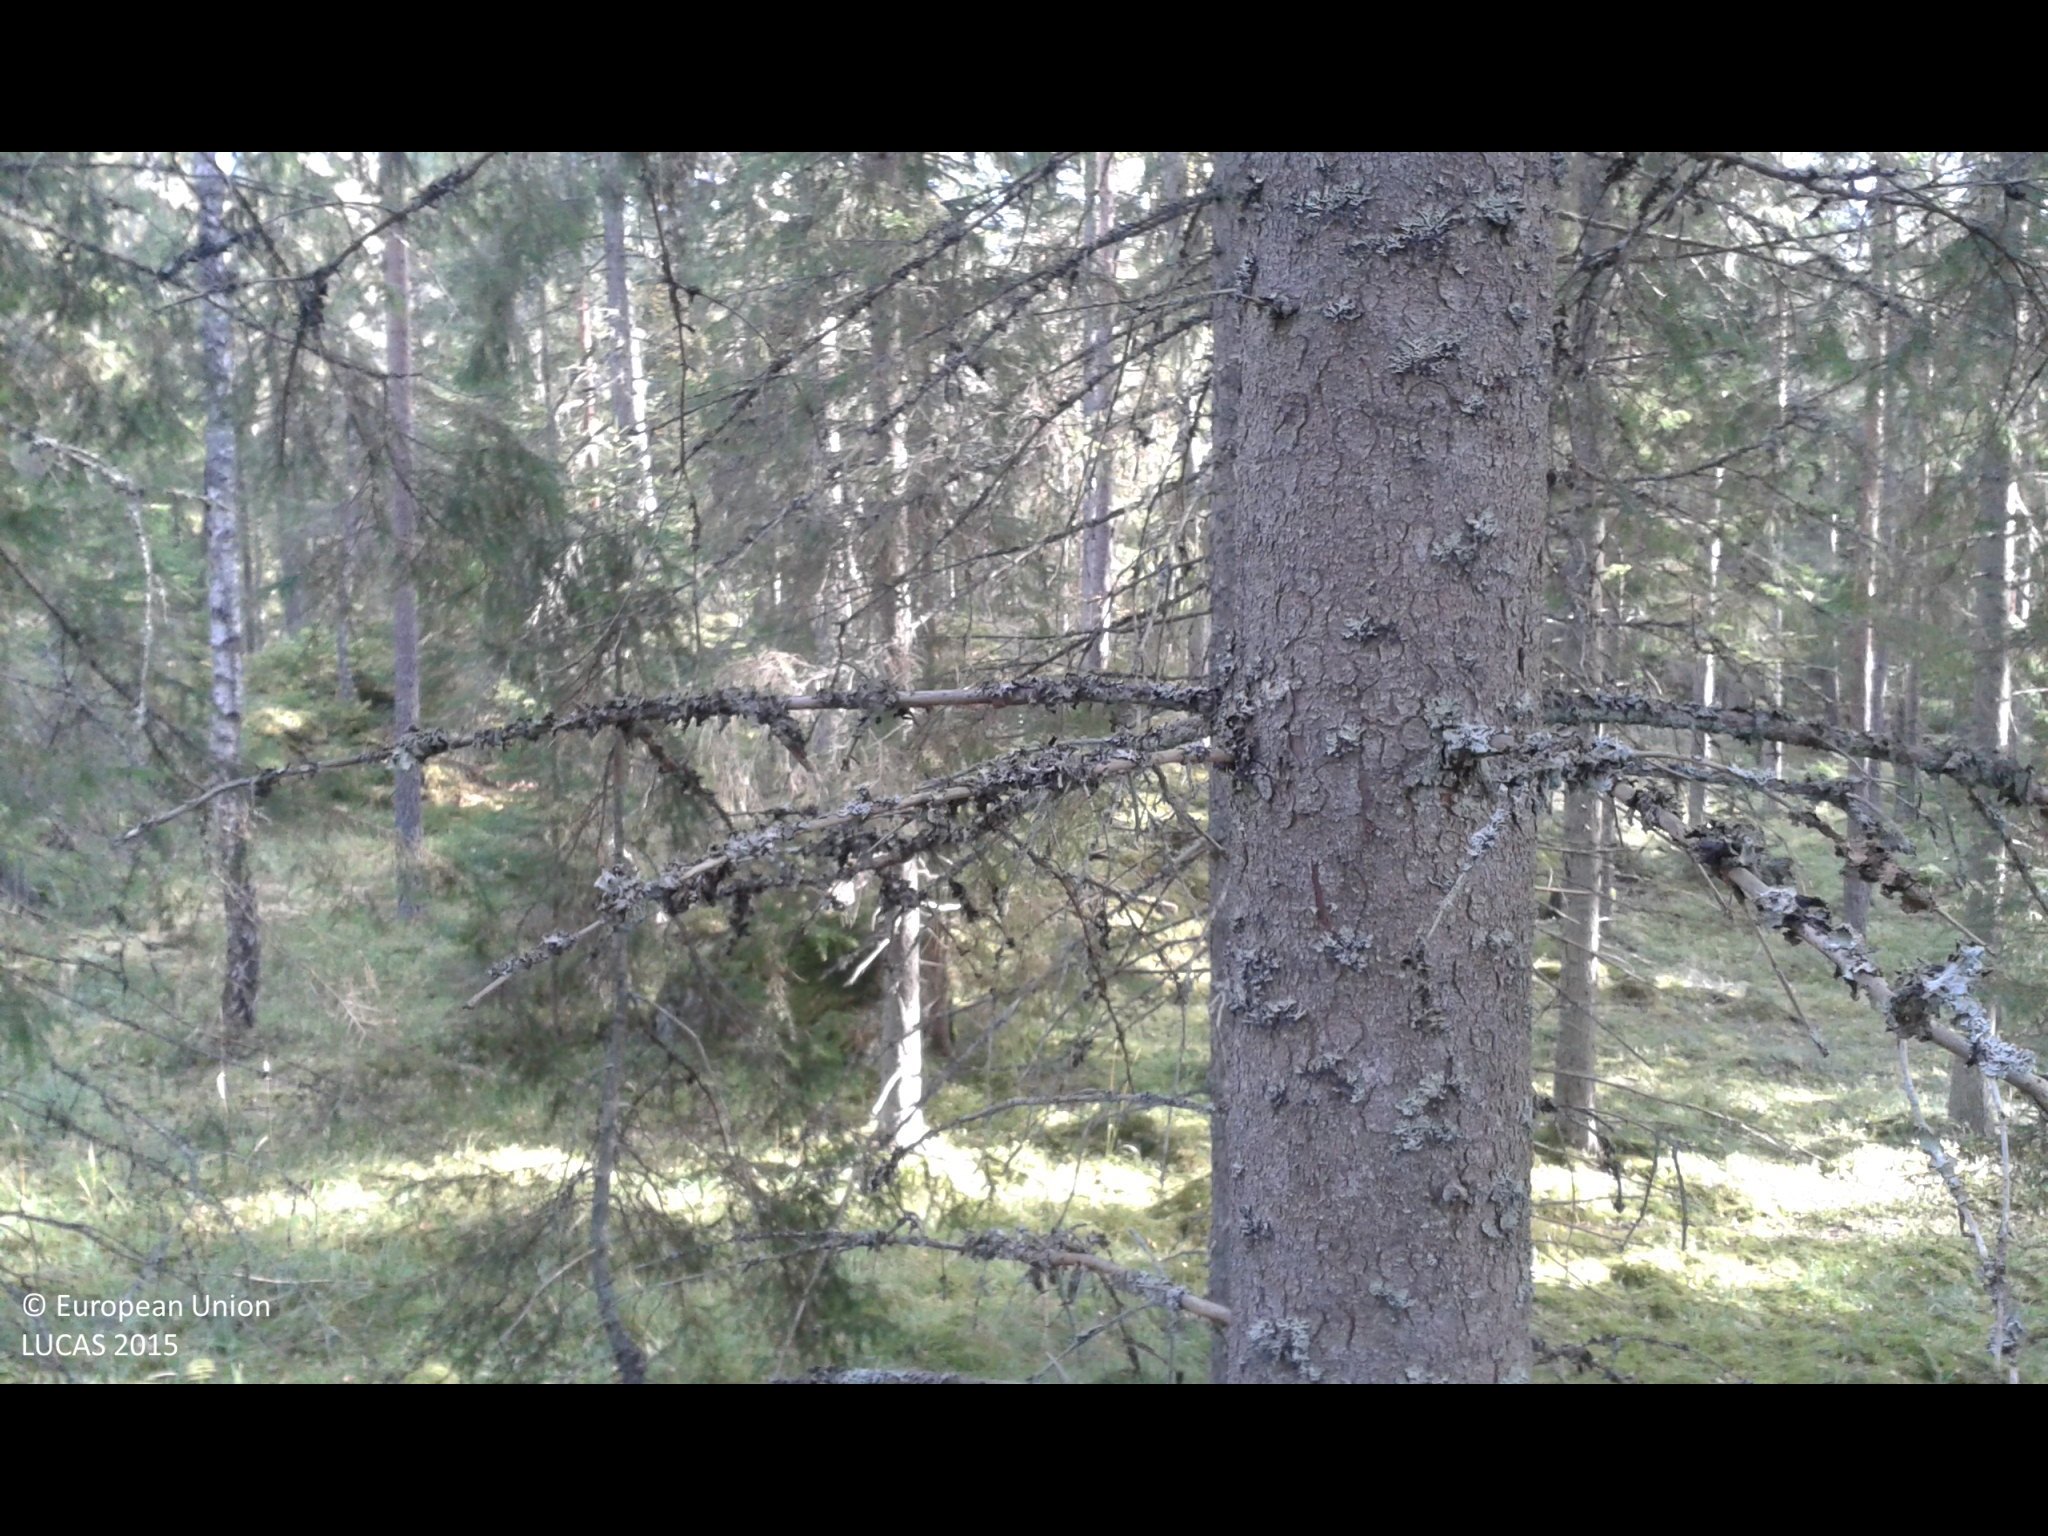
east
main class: Woodland
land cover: Spruce dominated coniferous woodland
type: boreal forest
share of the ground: > 75 %
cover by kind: coniferous forest trees 80 %, herbaceous plants 20 %
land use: Forestry
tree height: > 5 m
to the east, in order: Spruce dominated coniferous woodland; Ditches and canals; Tracks; Ditches and canals; Spruce dominated coniferous woodland
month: October
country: SE
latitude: 58.9186
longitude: 17.4130
